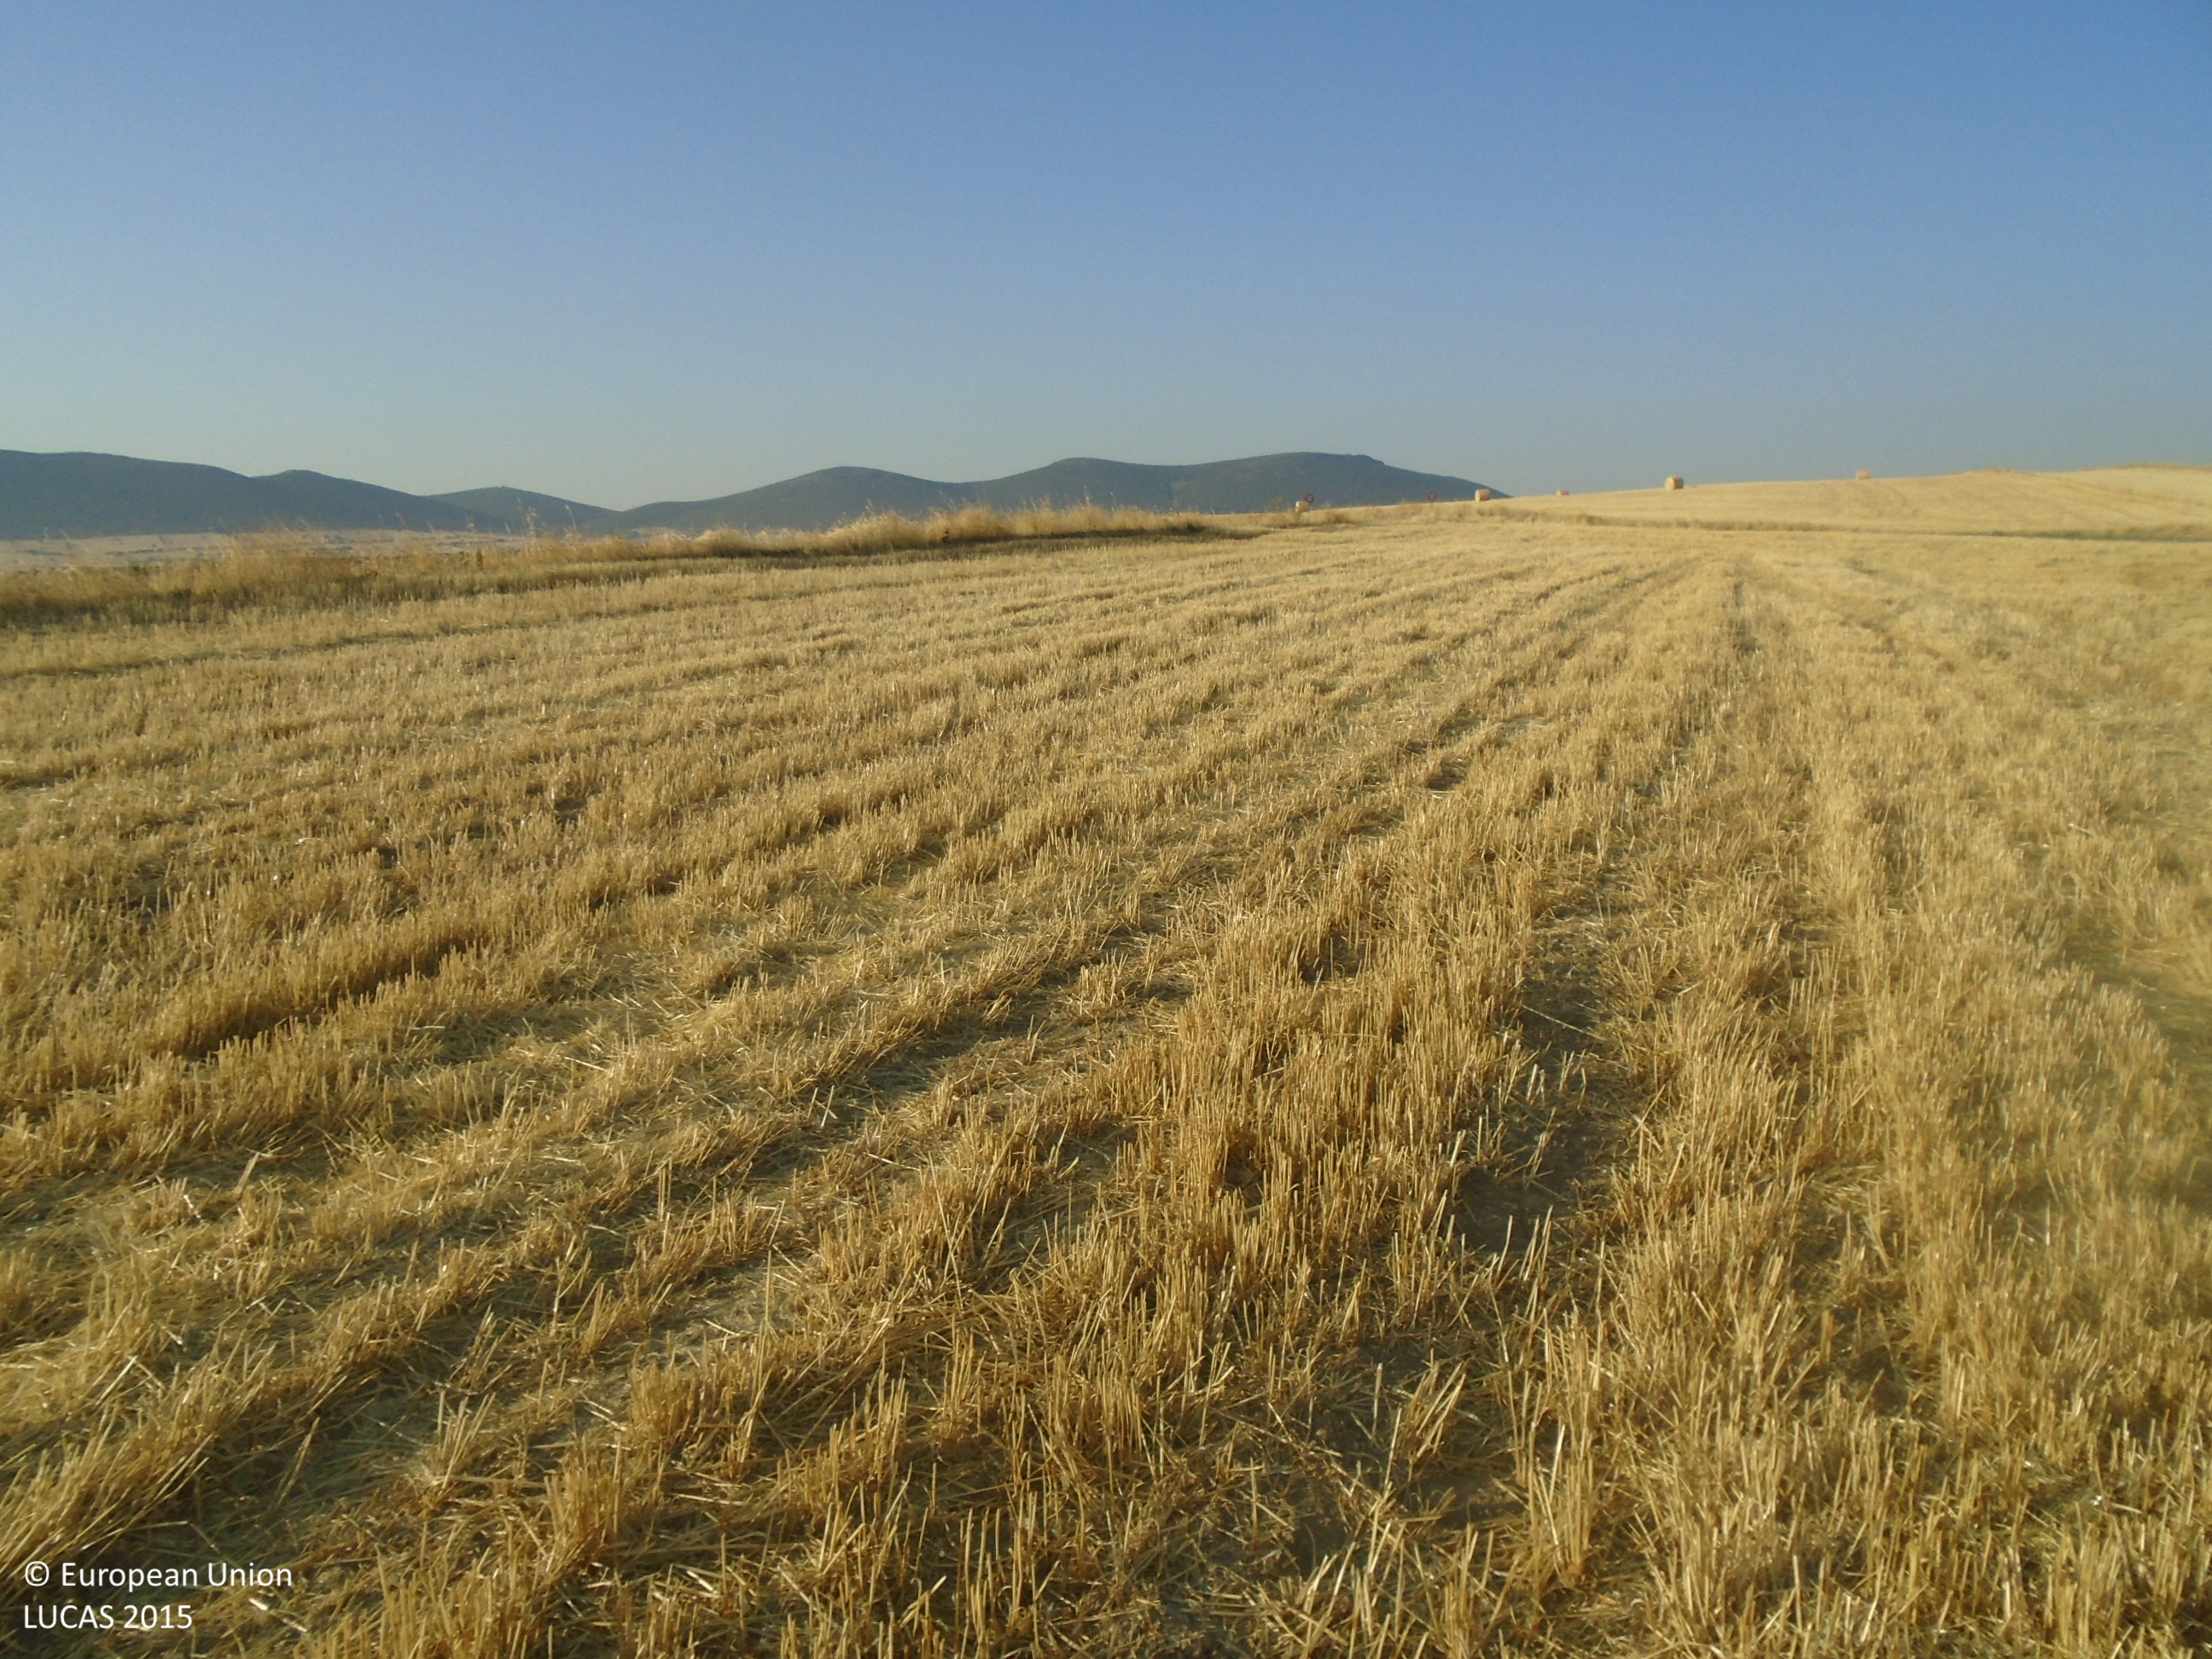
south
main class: Cropland
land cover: Barley
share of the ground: > 75 %
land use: Agriculture (excluding fallow land and kitchen gardens)
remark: Harvested field
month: July
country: ES
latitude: 39.3910
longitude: -3.7129
